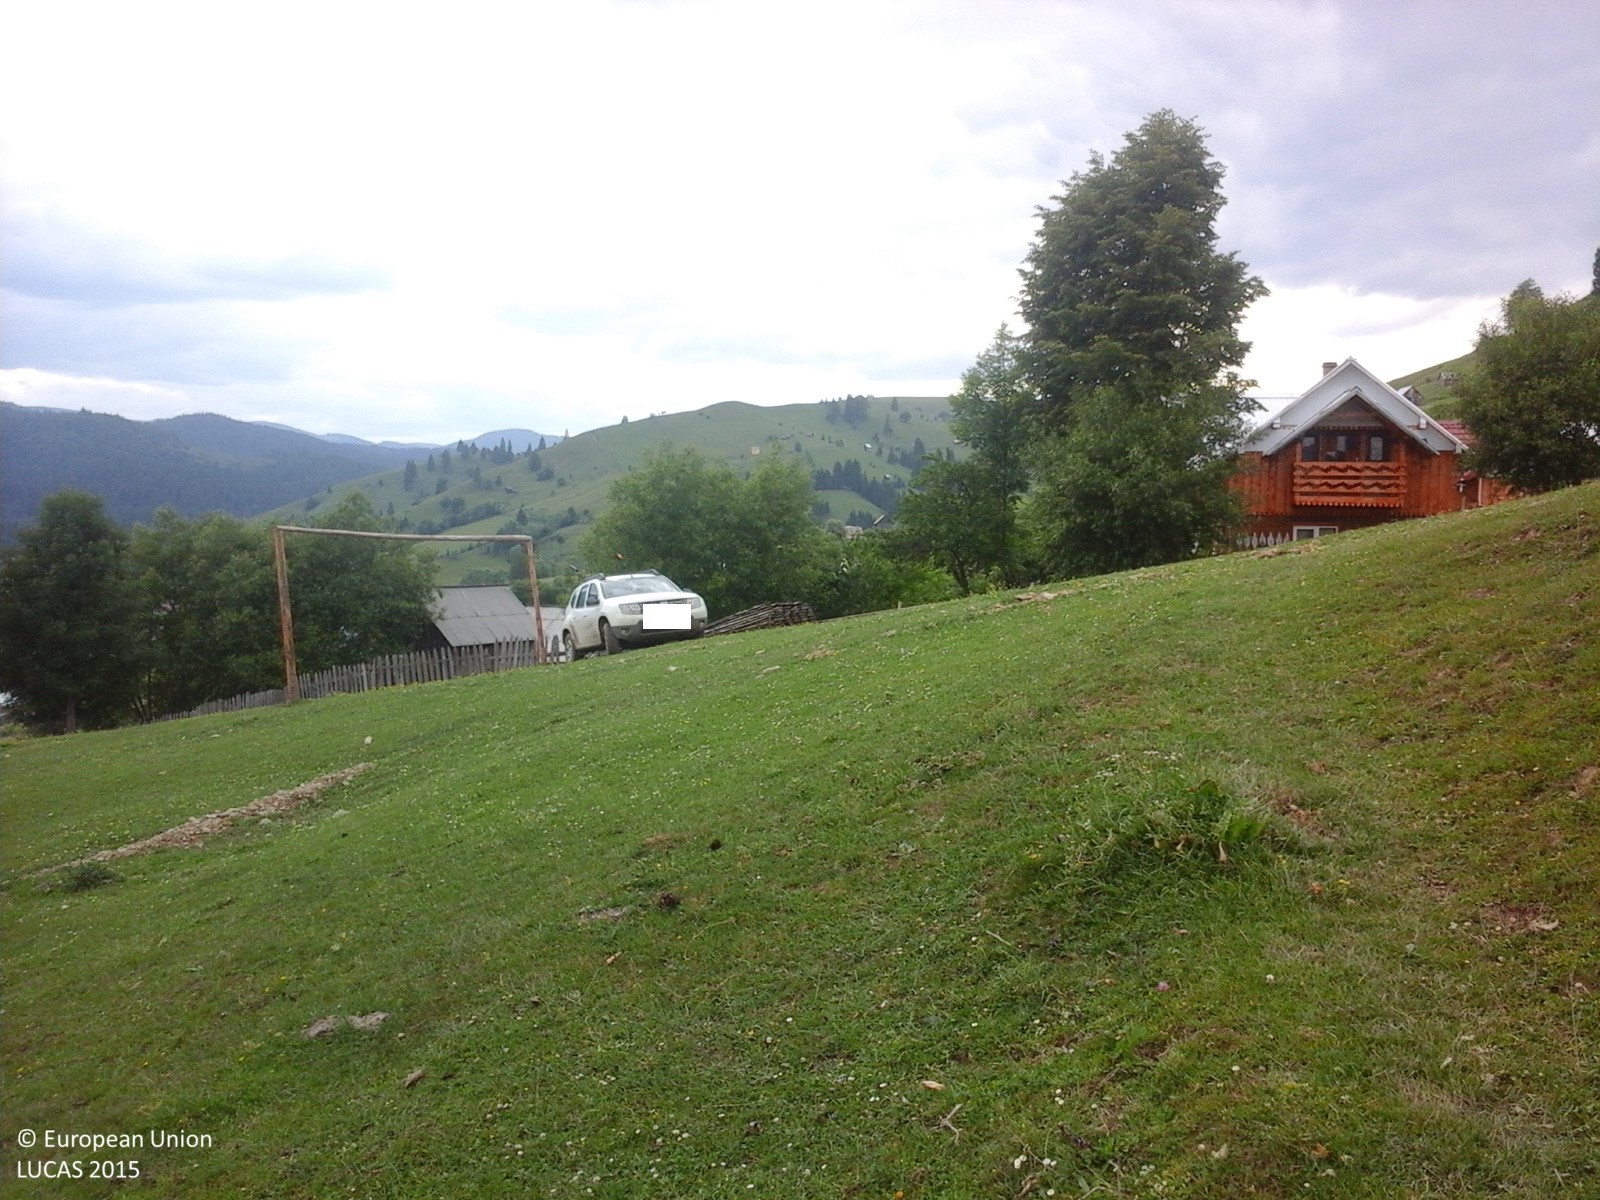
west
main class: Grassland
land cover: Grassland without tree/shrub cover
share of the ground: > 75 %
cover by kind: herbaceous plants 100 %
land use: Agriculture (excluding fallow land and kitchen gardens)
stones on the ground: < 10 %
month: June
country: RO
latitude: 47.7034
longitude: 25.5100
